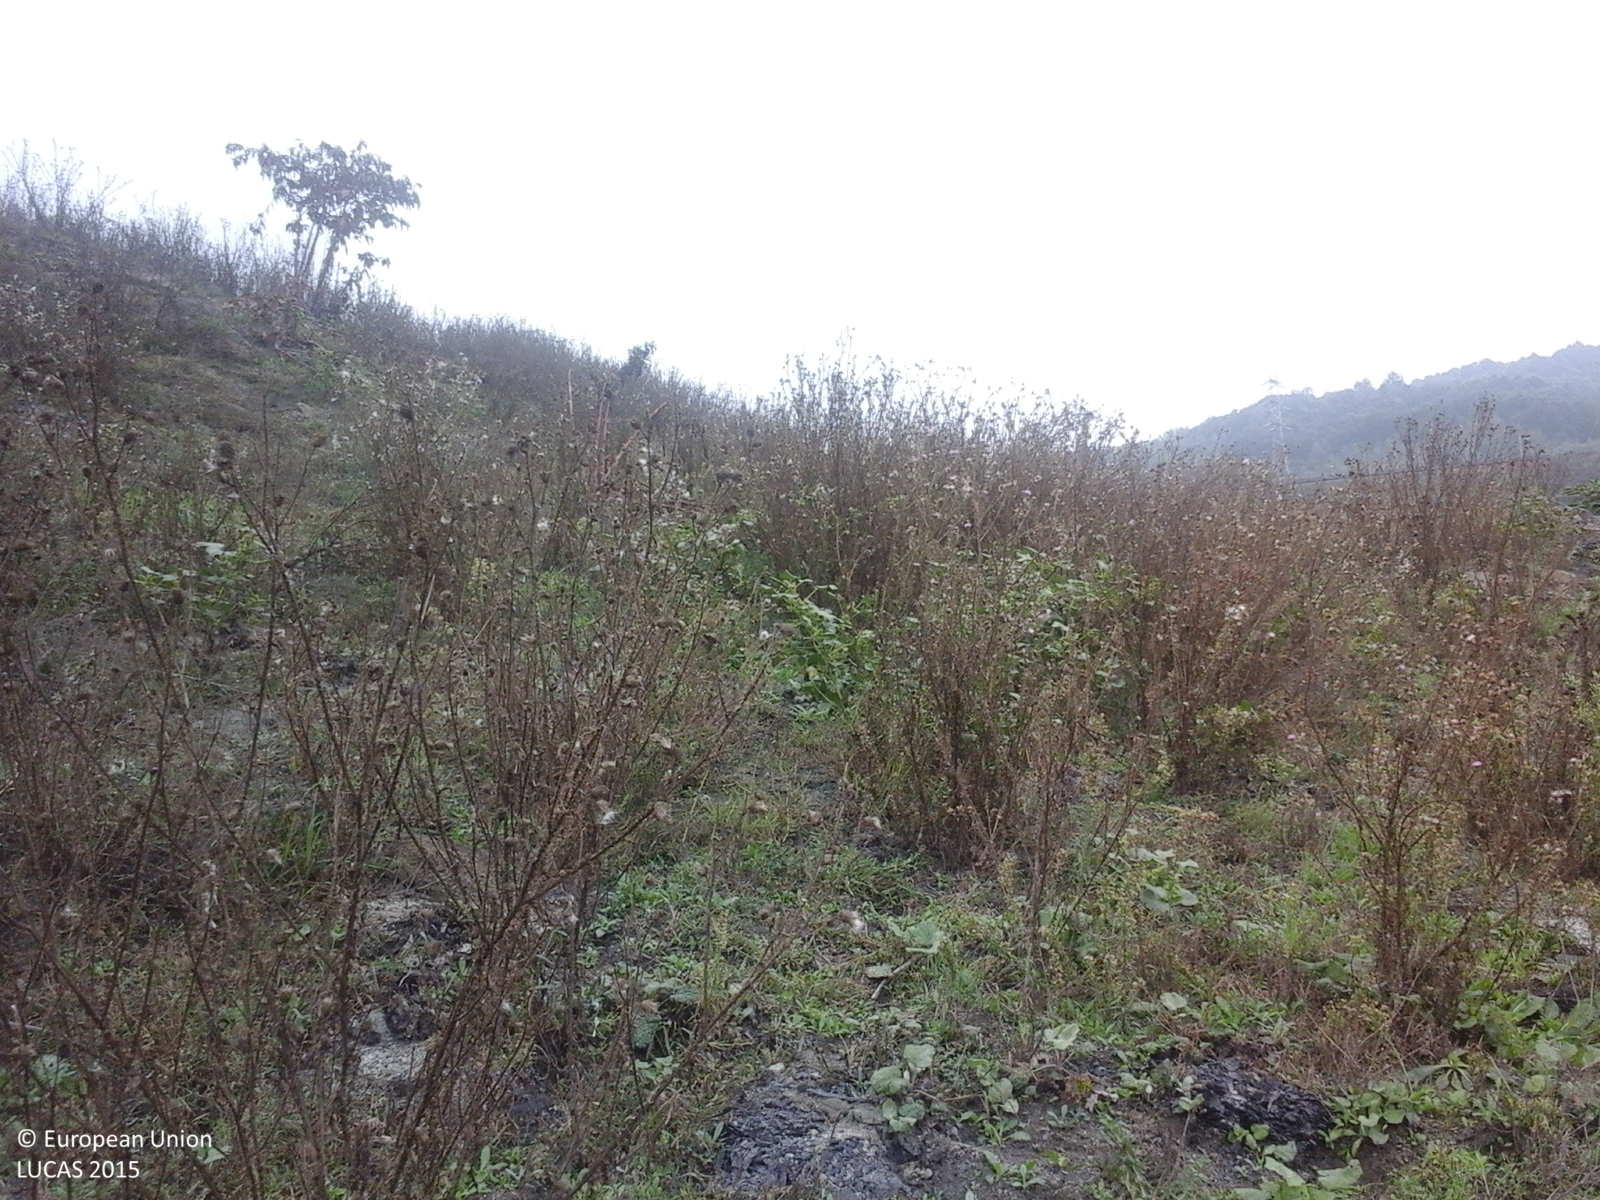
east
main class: Grassland
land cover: Spontaneously vegetated surfaces
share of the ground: > 75 %
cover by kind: herbaceous plants 100 %
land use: Mining and quarrying
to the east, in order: Spontaneously vegetated surfaces; Rocks and stones; Tracks; Rocks and stones
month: September
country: RO
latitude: 44.9198
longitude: 23.1113
